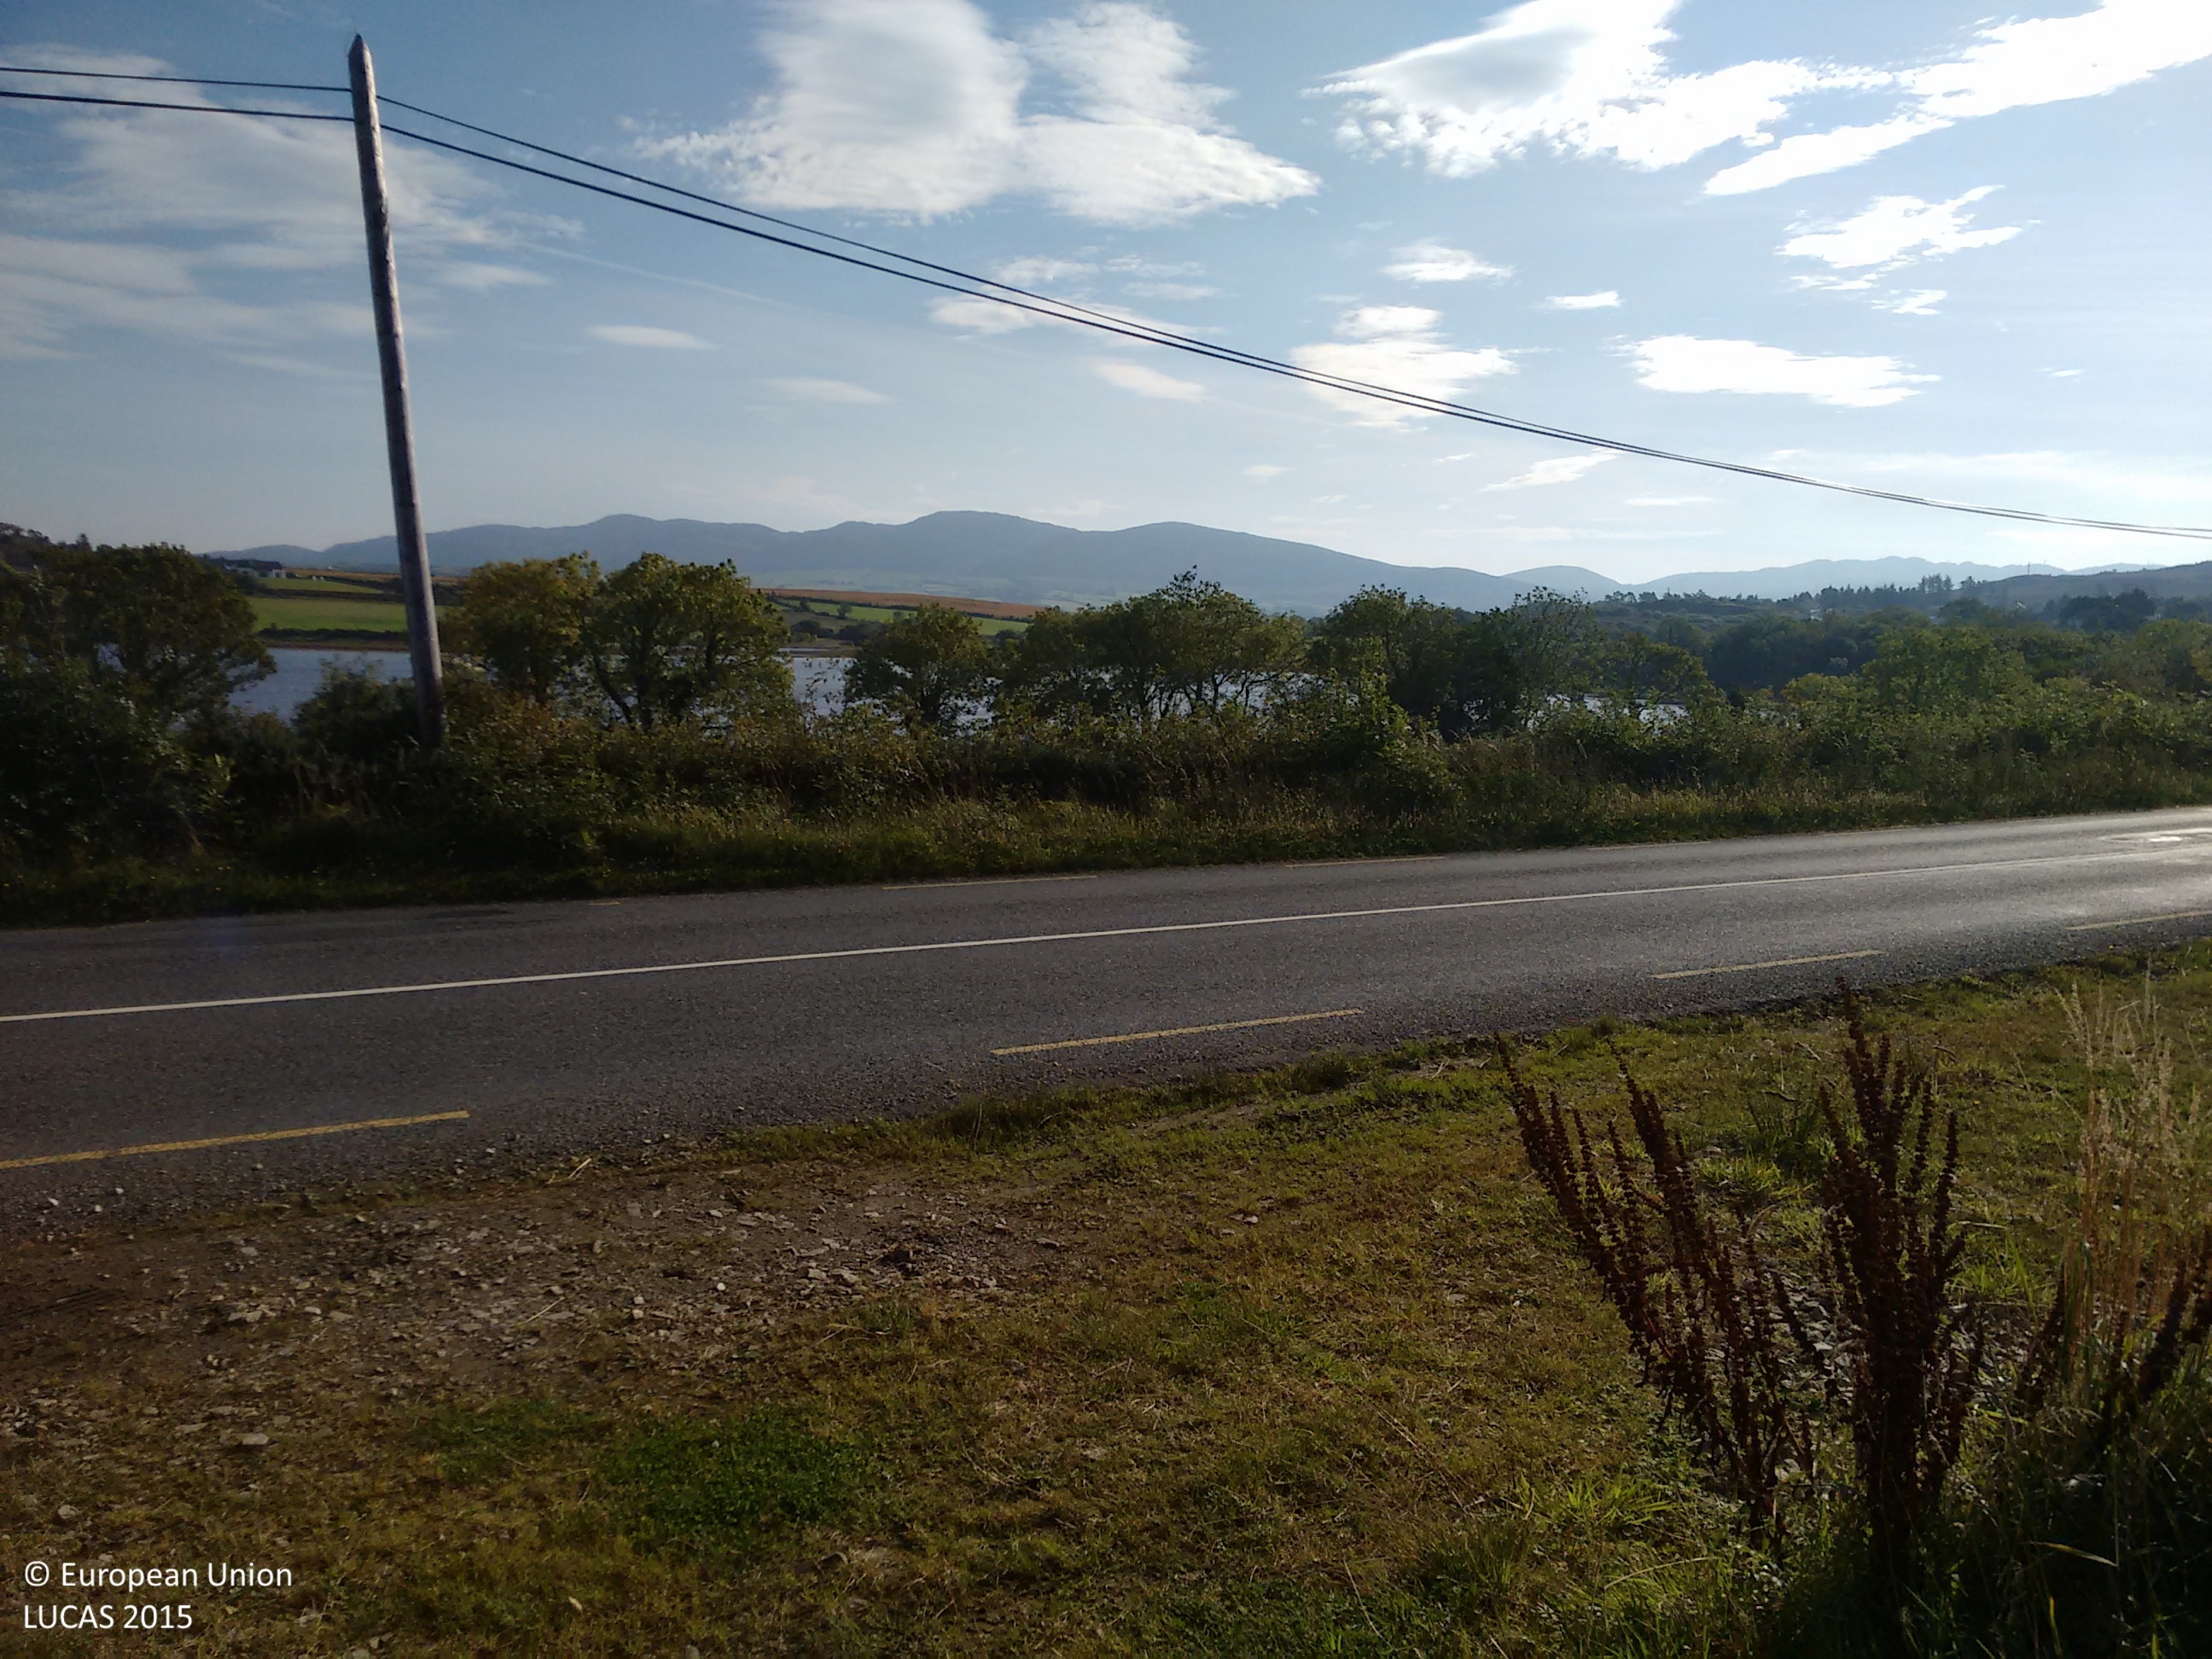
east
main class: Grassland
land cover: Grassland without tree/shrub cover
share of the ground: > 75 %
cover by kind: herbaceous plants 100 %
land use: Agriculture (excluding fallow land and kitchen gardens)
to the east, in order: Managed hedges; Grassland without tree/shrub cover; Electric lines; Grassland without tree/shrub cover; Fences; Managed hedges; Grassland without tree/shrub cover; Fences; Electric lines; Grassland without tree/shrub cover; Fences; Broadleaved woodland; Grass margins; Paved roads, cycling and walking lanes; Grass margins; Abandoned hedges; Electric lines; Broadleaved woodland; Inland marshes
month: September
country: IE
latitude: 55.1598
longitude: -7.7243
